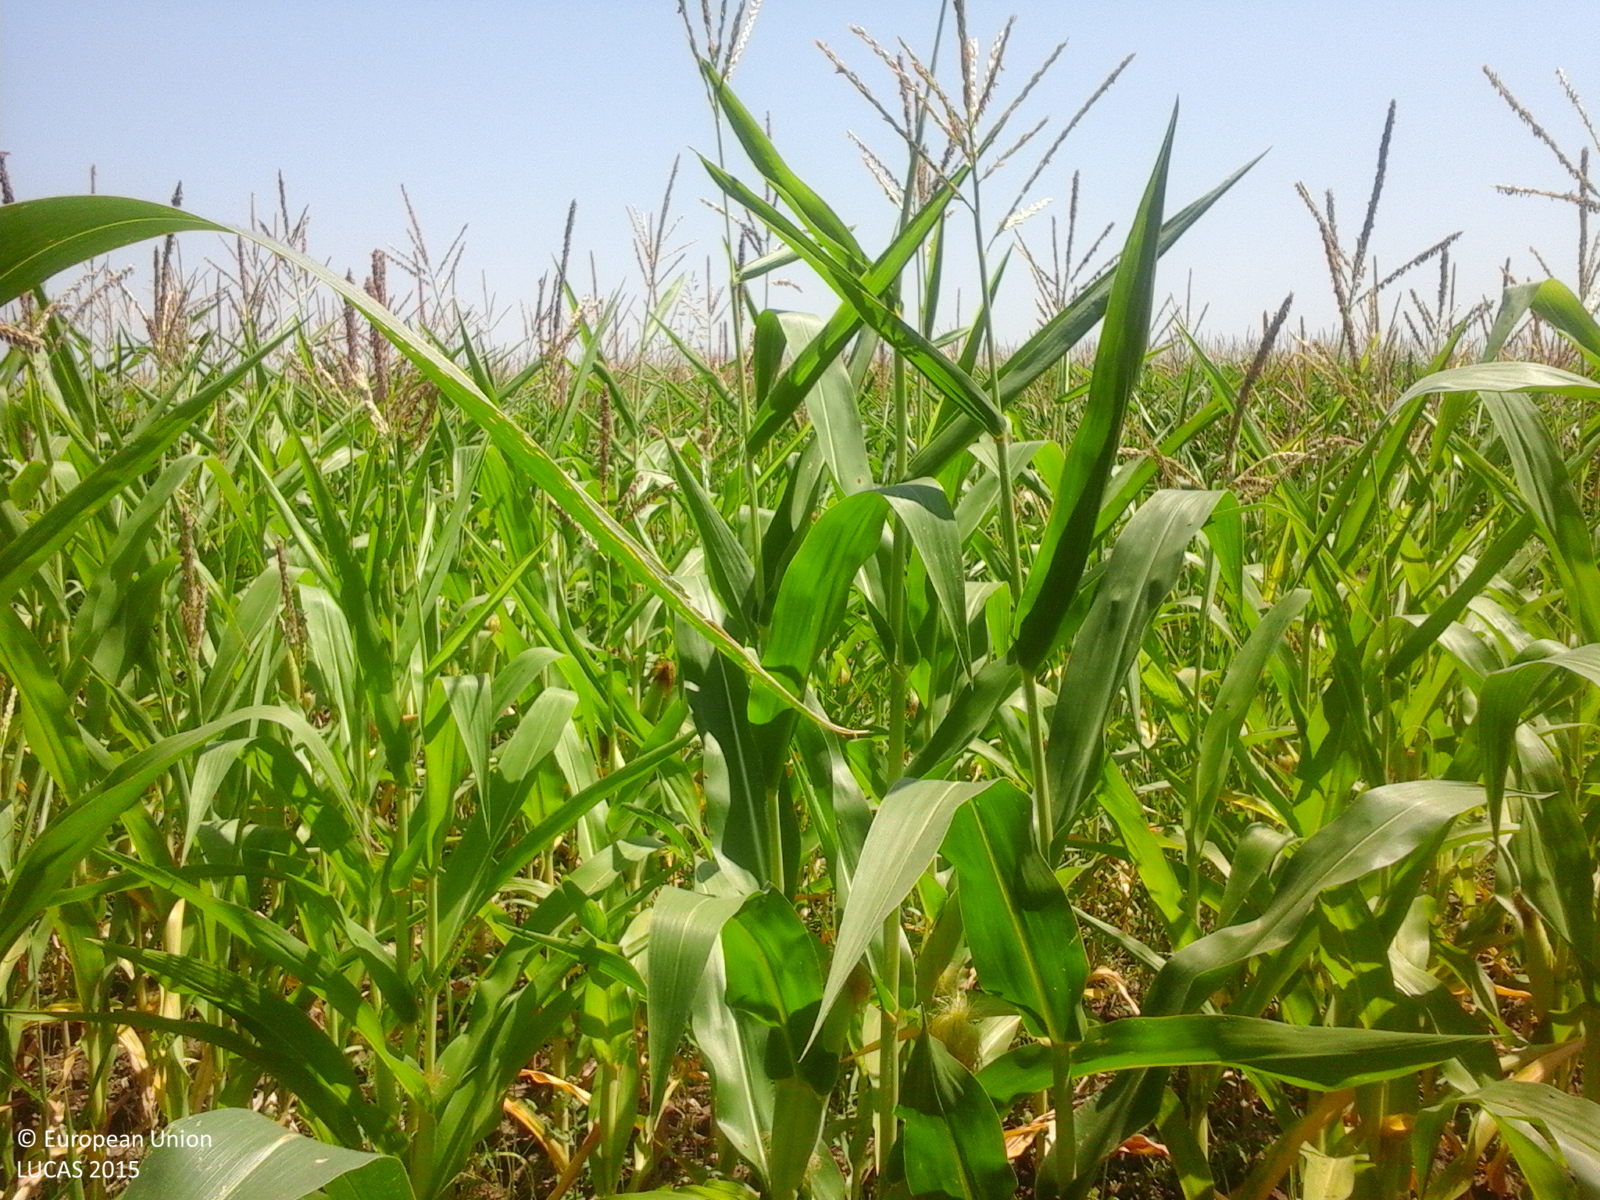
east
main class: Cropland
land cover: Maize
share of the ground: > 75 %
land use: Agriculture (excluding fallow land and kitchen gardens)
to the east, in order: Maize; Common wheat
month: July
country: RO
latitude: 44.7548
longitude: 26.7876
